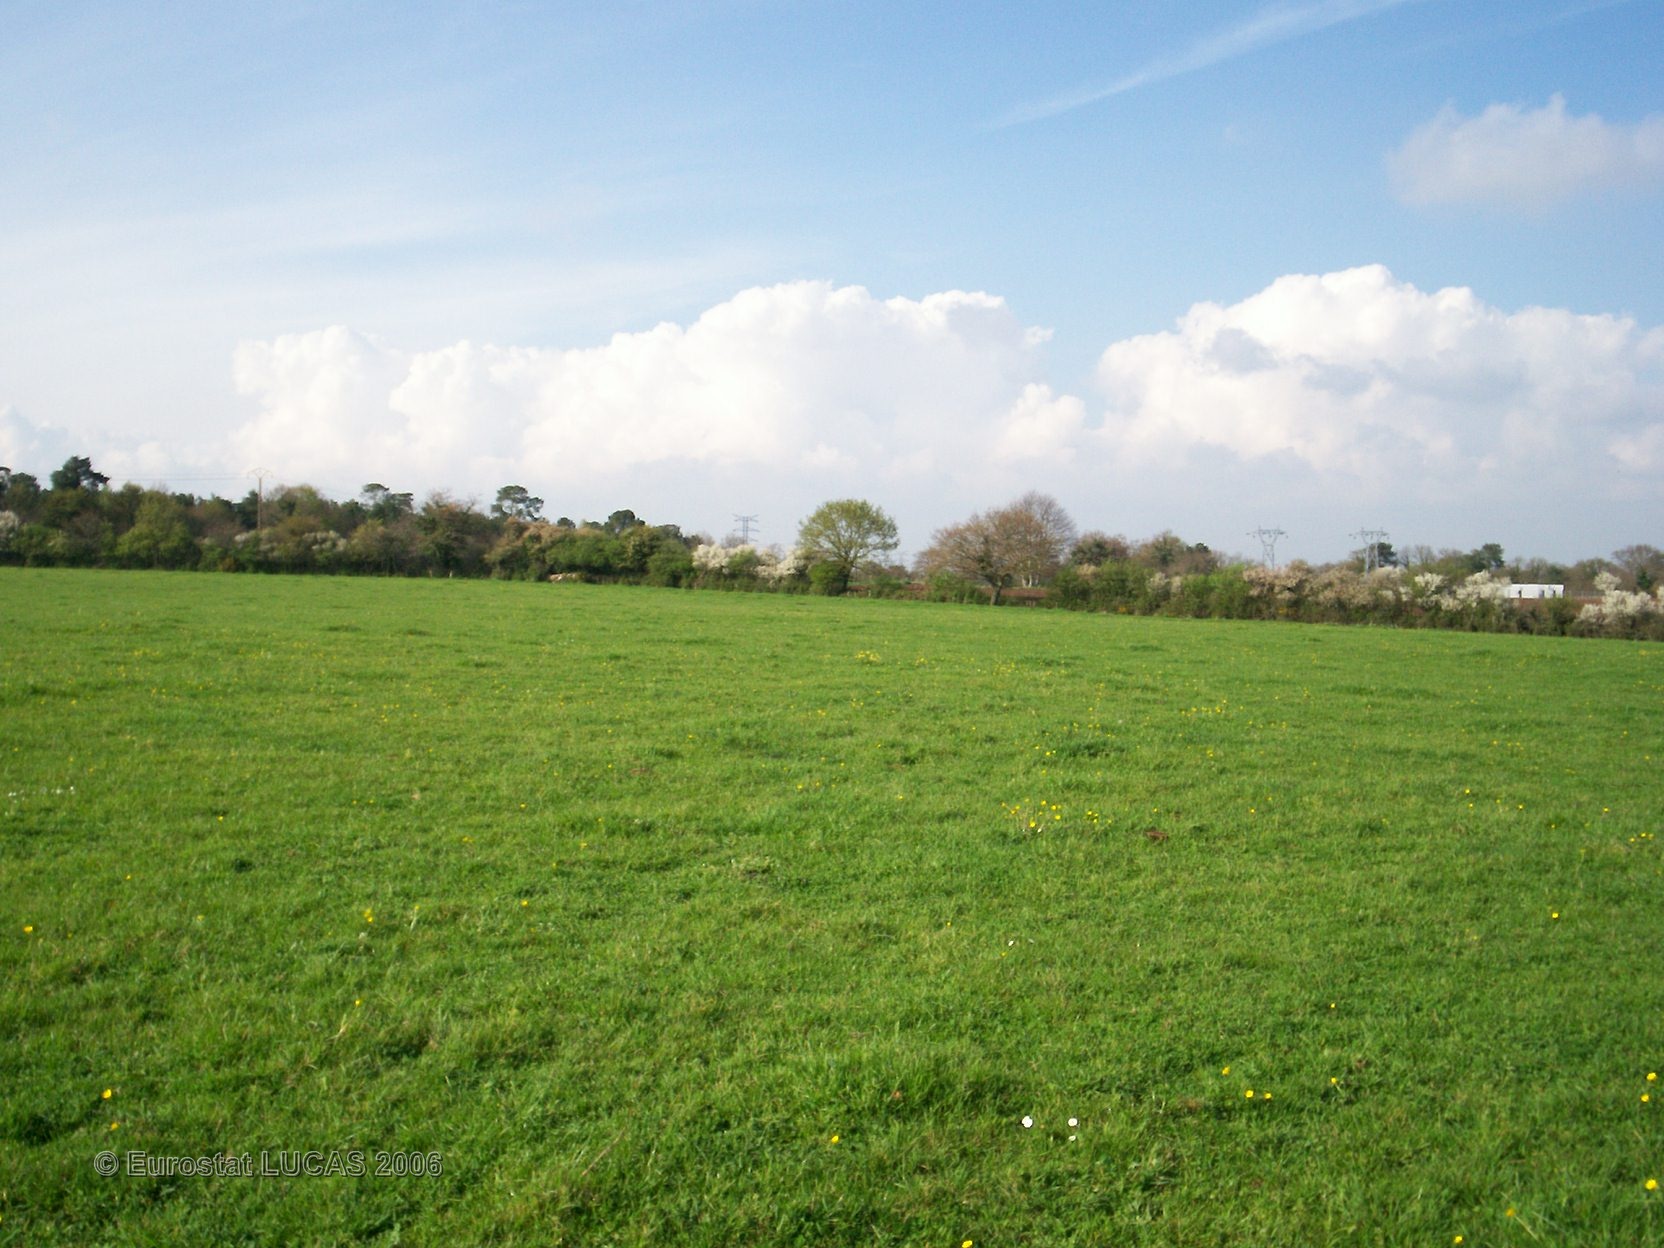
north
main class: Grassland
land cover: Grassland without tree/shrub cover
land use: Agriculture (excluding fallow land and kitchen gardens)
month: April
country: FR
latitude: 47.6522
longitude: -2.8308
